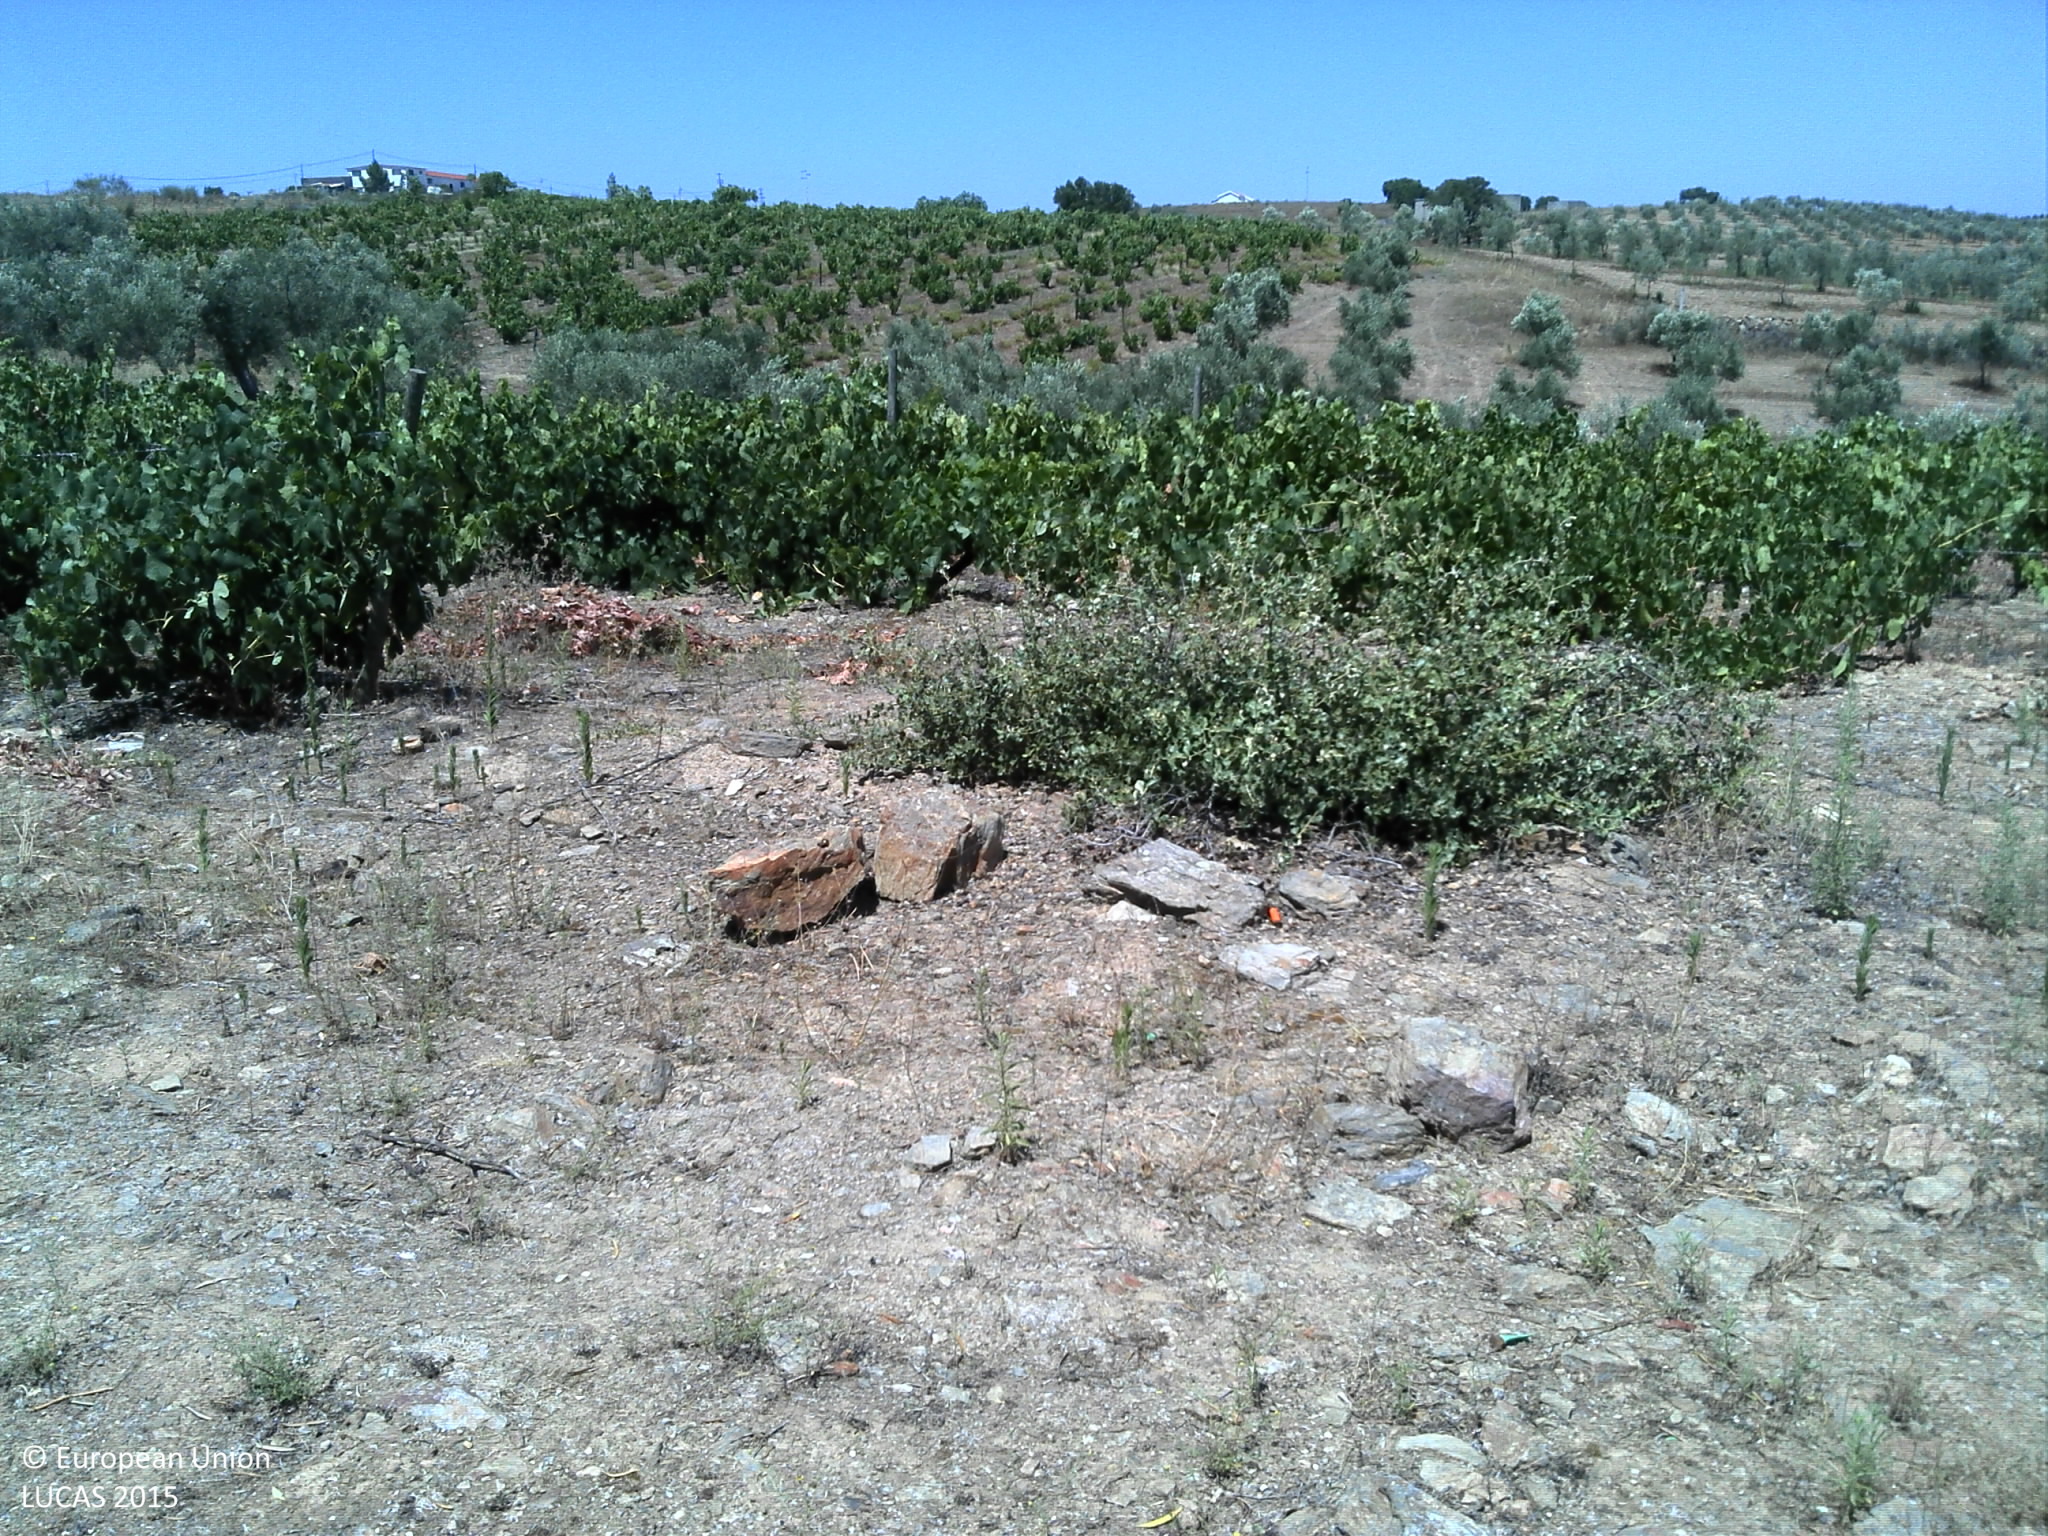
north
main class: Cropland
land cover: Olive groves
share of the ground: 25 - 50 %
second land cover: Grassland without tree/shrub cover
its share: 10 - 25 %
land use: Agriculture (excluding fallow land and kitchen gardens)
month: July
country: PT
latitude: 41.4204
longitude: -7.2410
